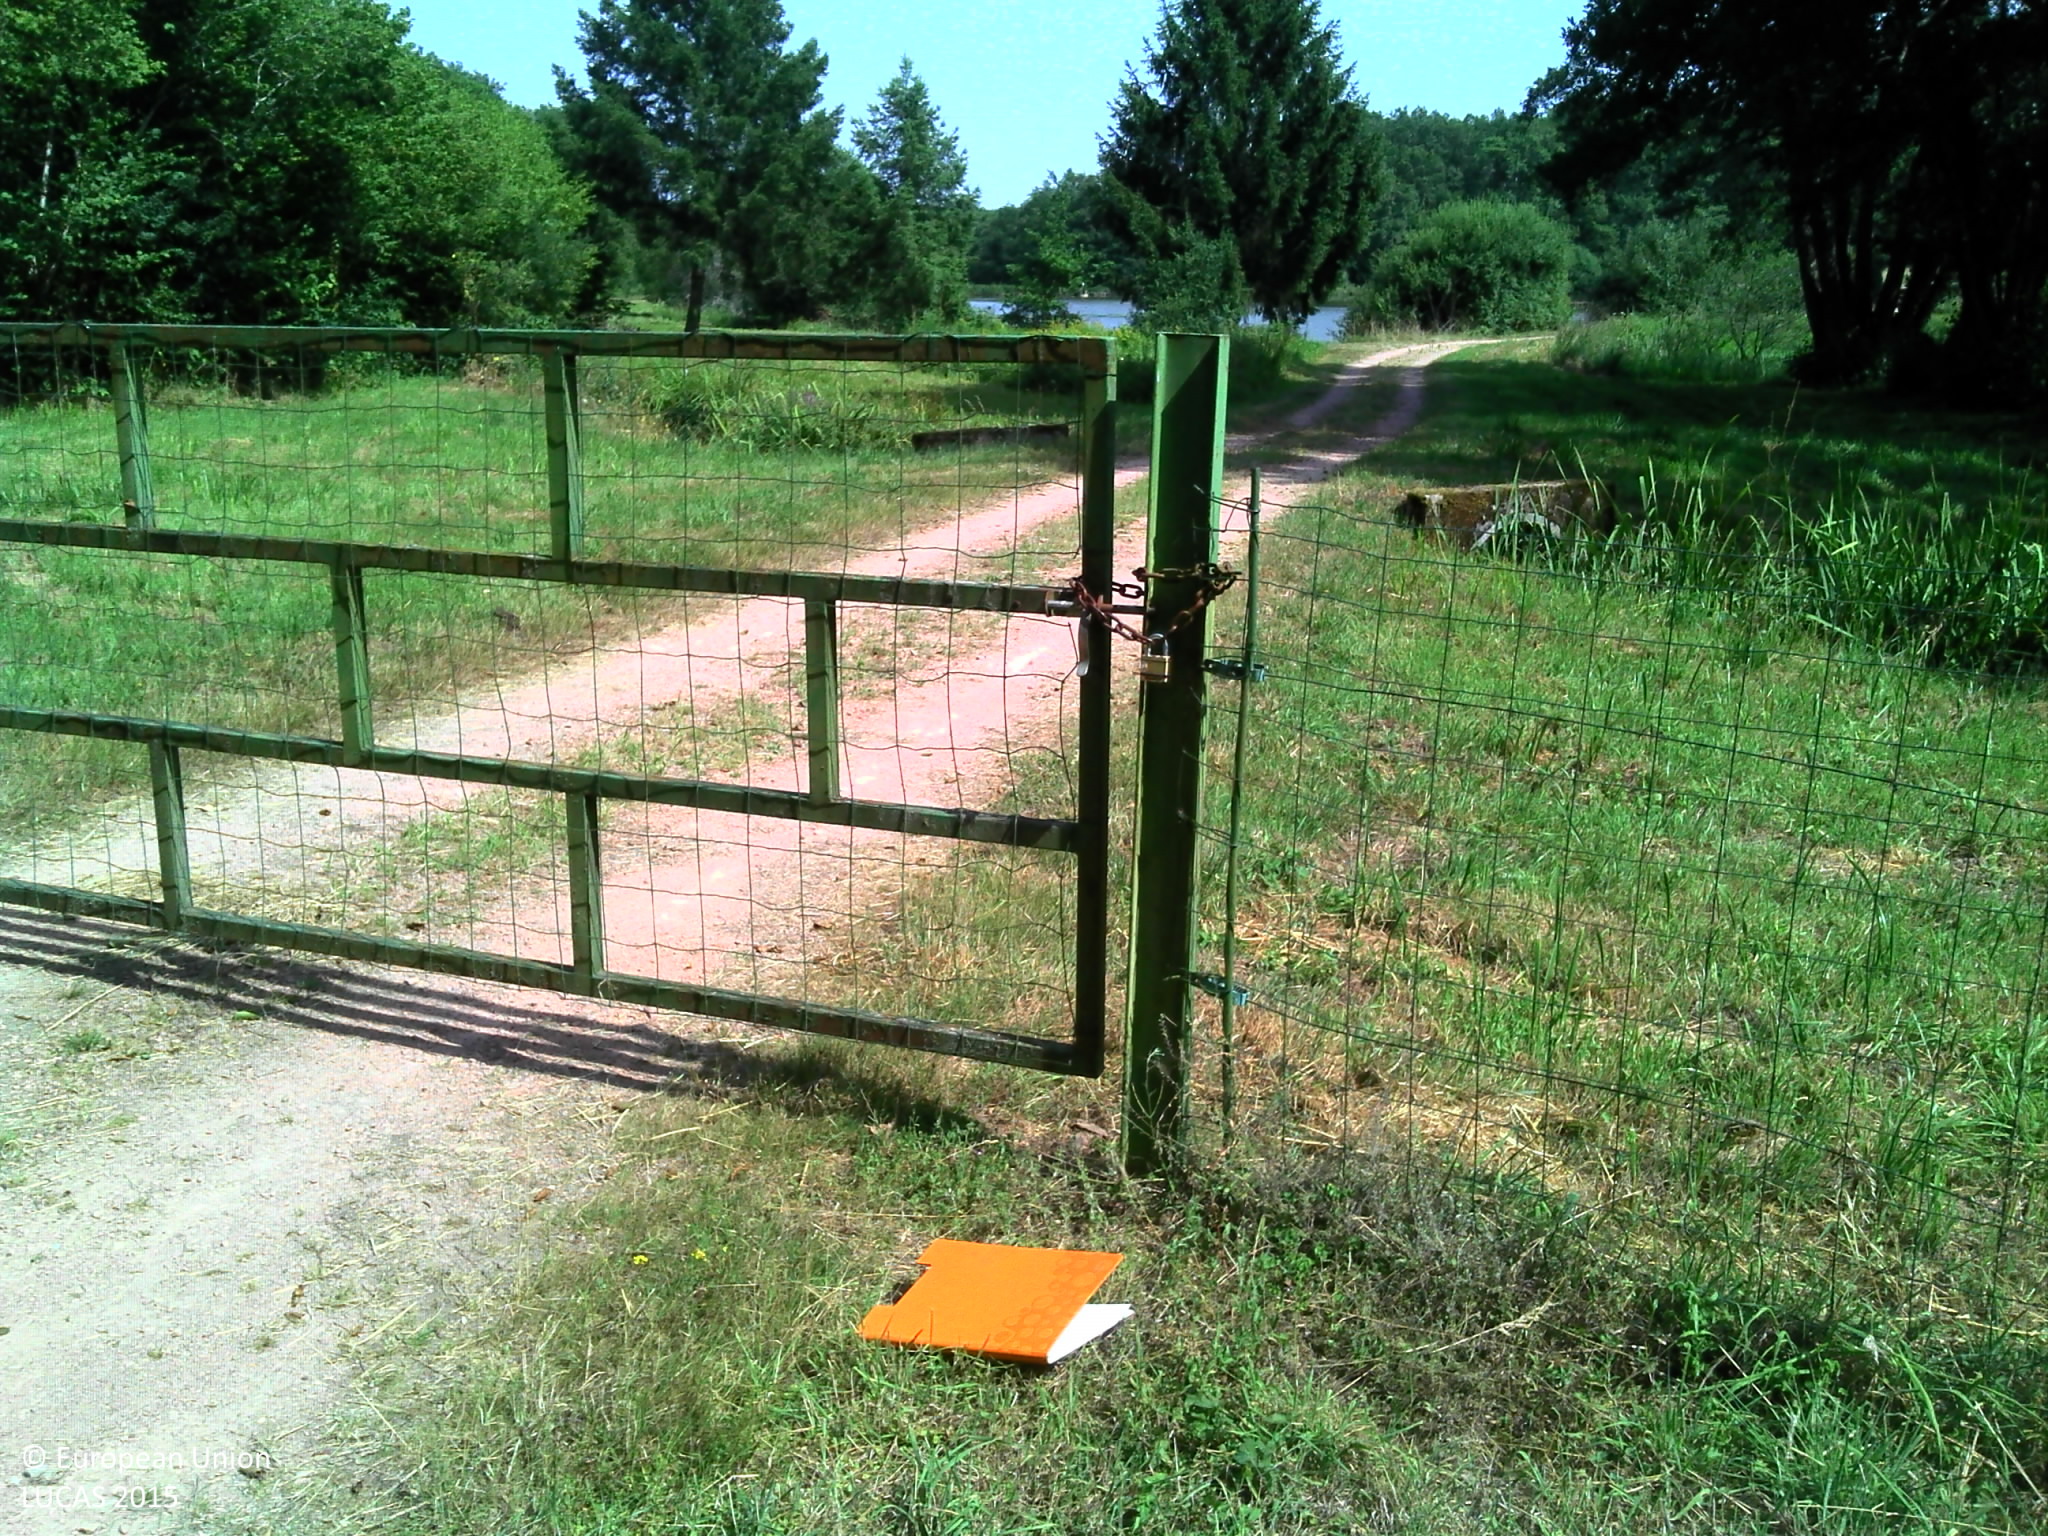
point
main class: Grassland
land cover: Grassland without tree/shrub cover
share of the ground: > 75 %
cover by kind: herbaceous plants 100 %
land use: Agriculture (excluding fallow land and kitchen gardens)
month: July
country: FR
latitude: 47.0407
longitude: 3.5354
